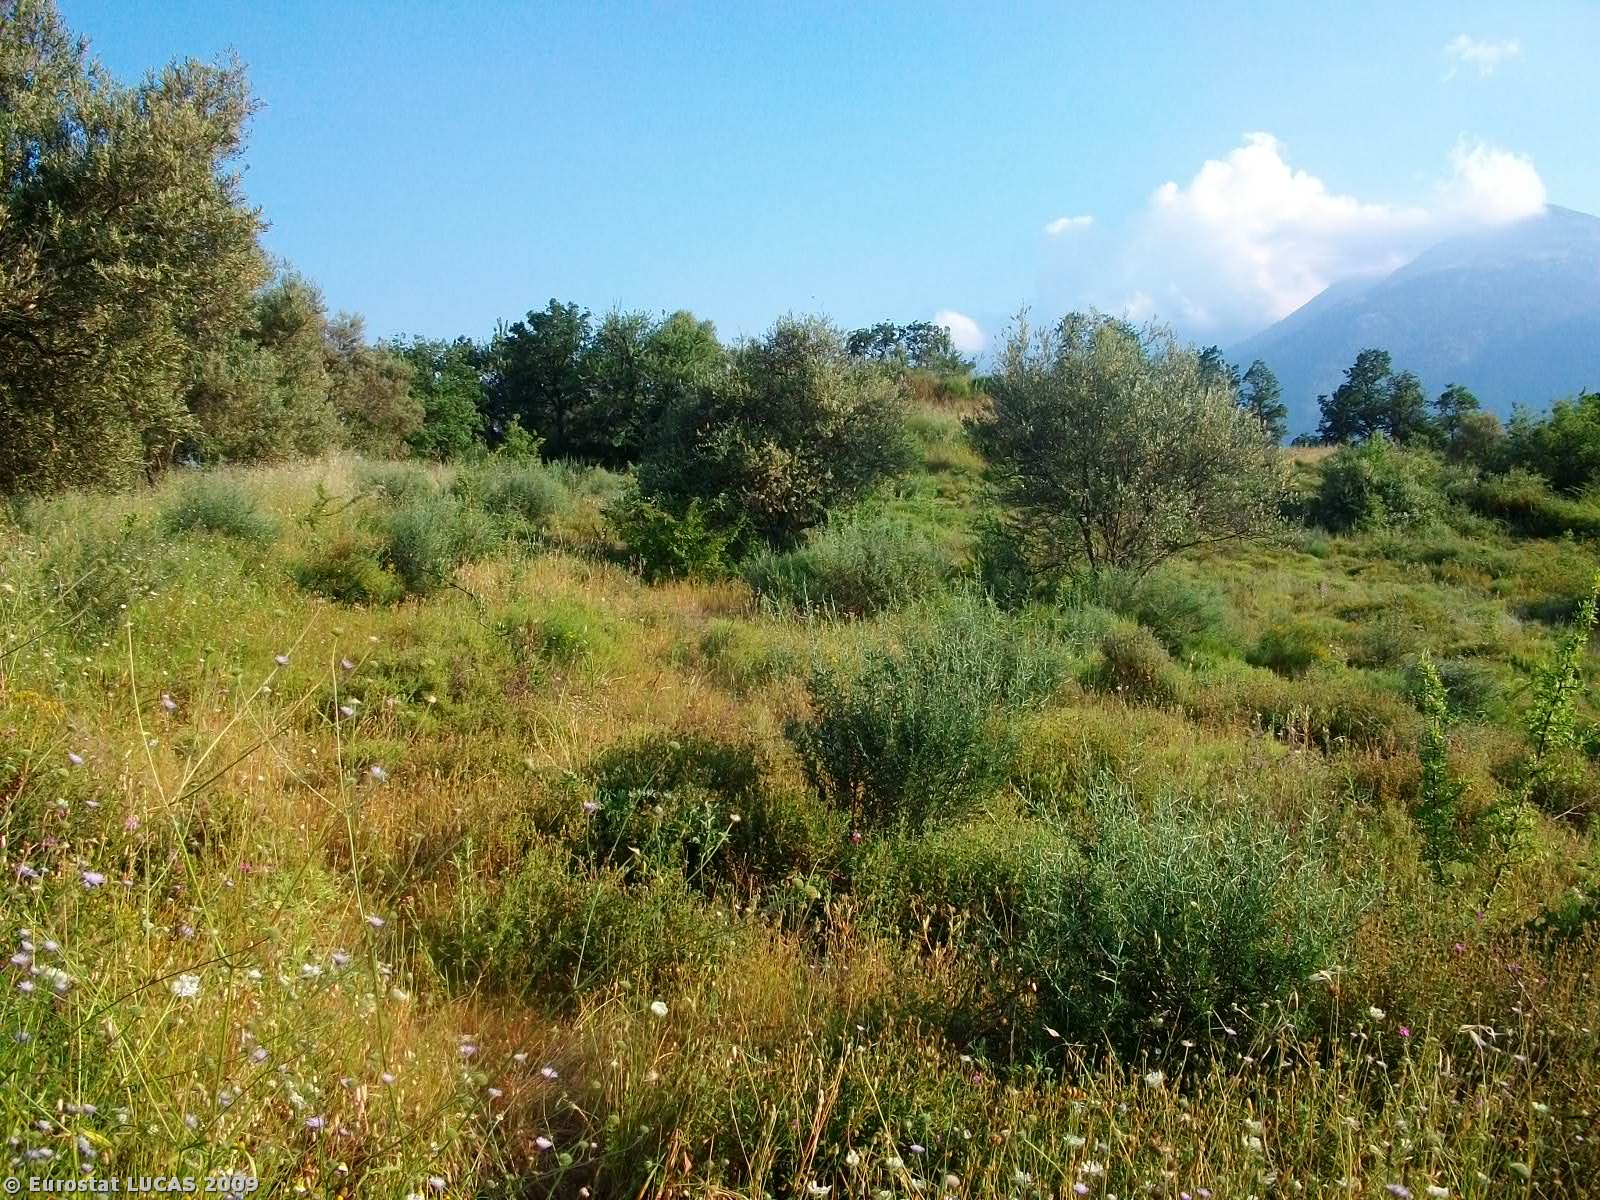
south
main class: Woodland
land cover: Broadleaved woodland
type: broadleaved evergreen forest
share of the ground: > 75 %
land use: Forestry
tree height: > 5 m
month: May
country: GR
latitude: 37.1793
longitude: 22.3355
